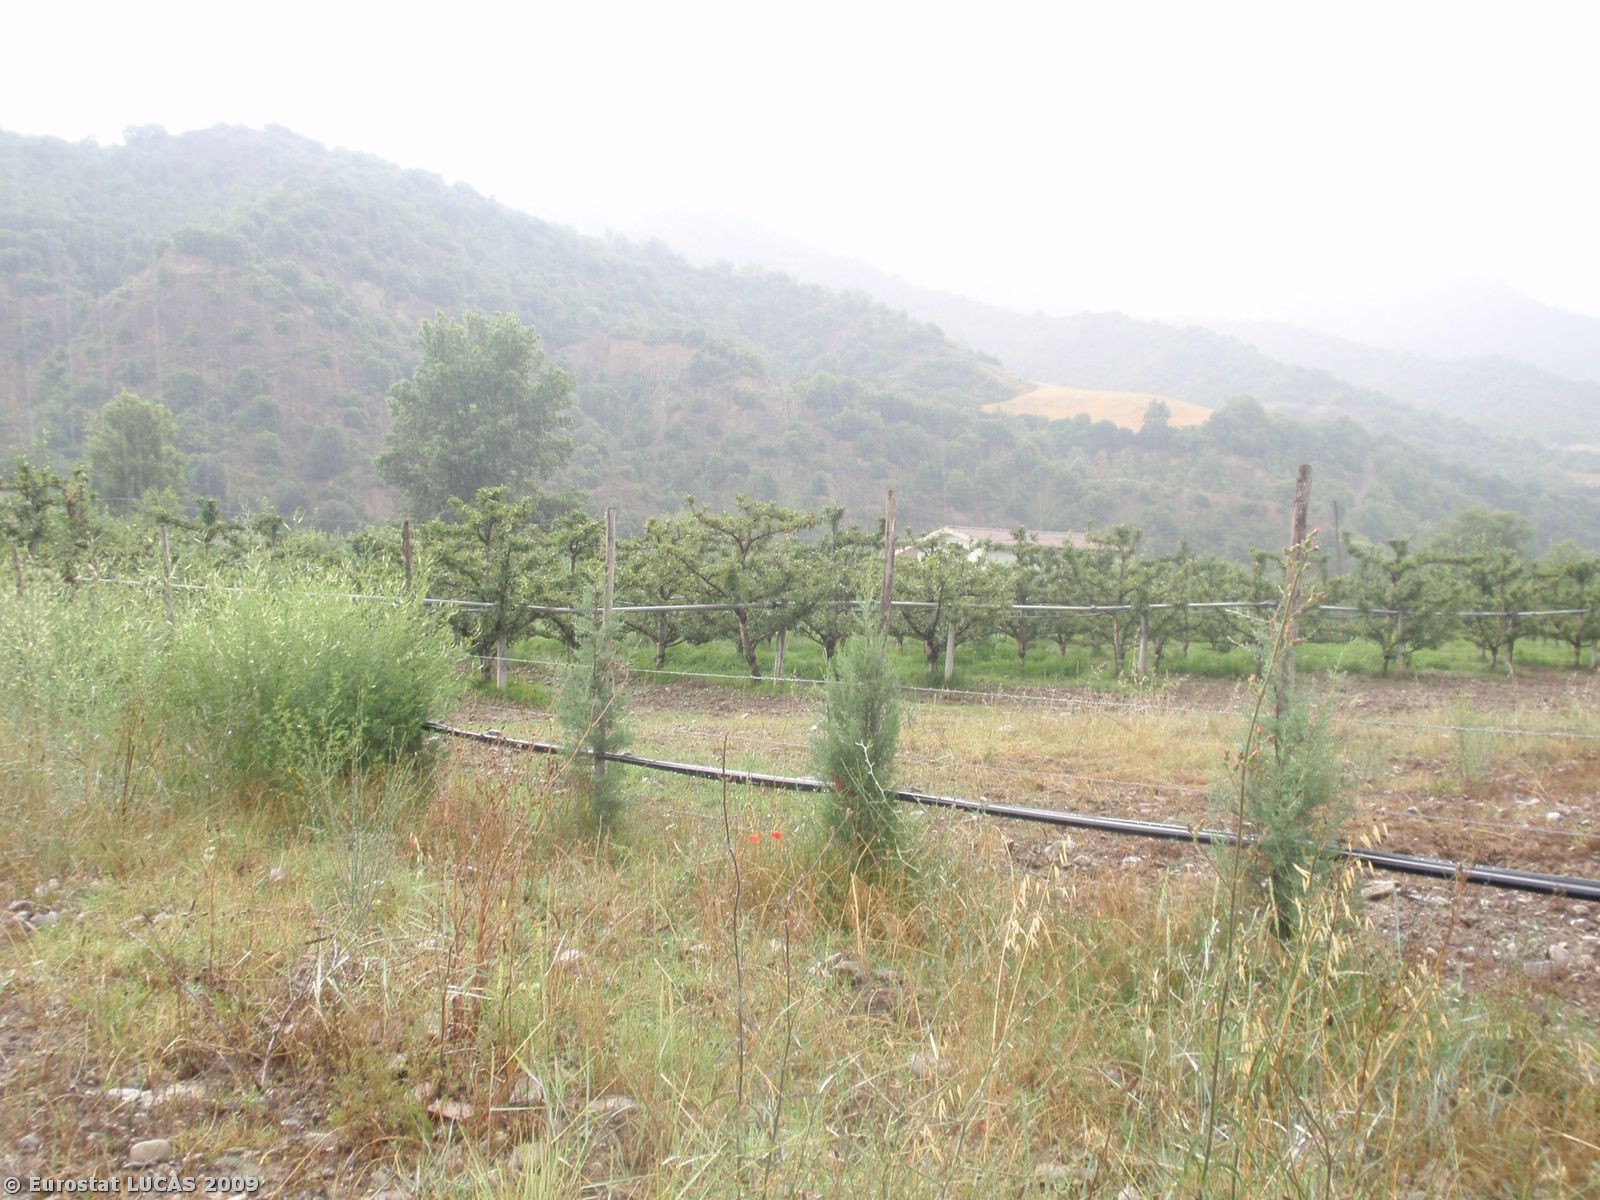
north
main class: Grassland
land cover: Spontaneously vegetated surfaces
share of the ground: > 75 %
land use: Fallow land
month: June
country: IT
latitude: 40.2588
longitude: 16.1010
